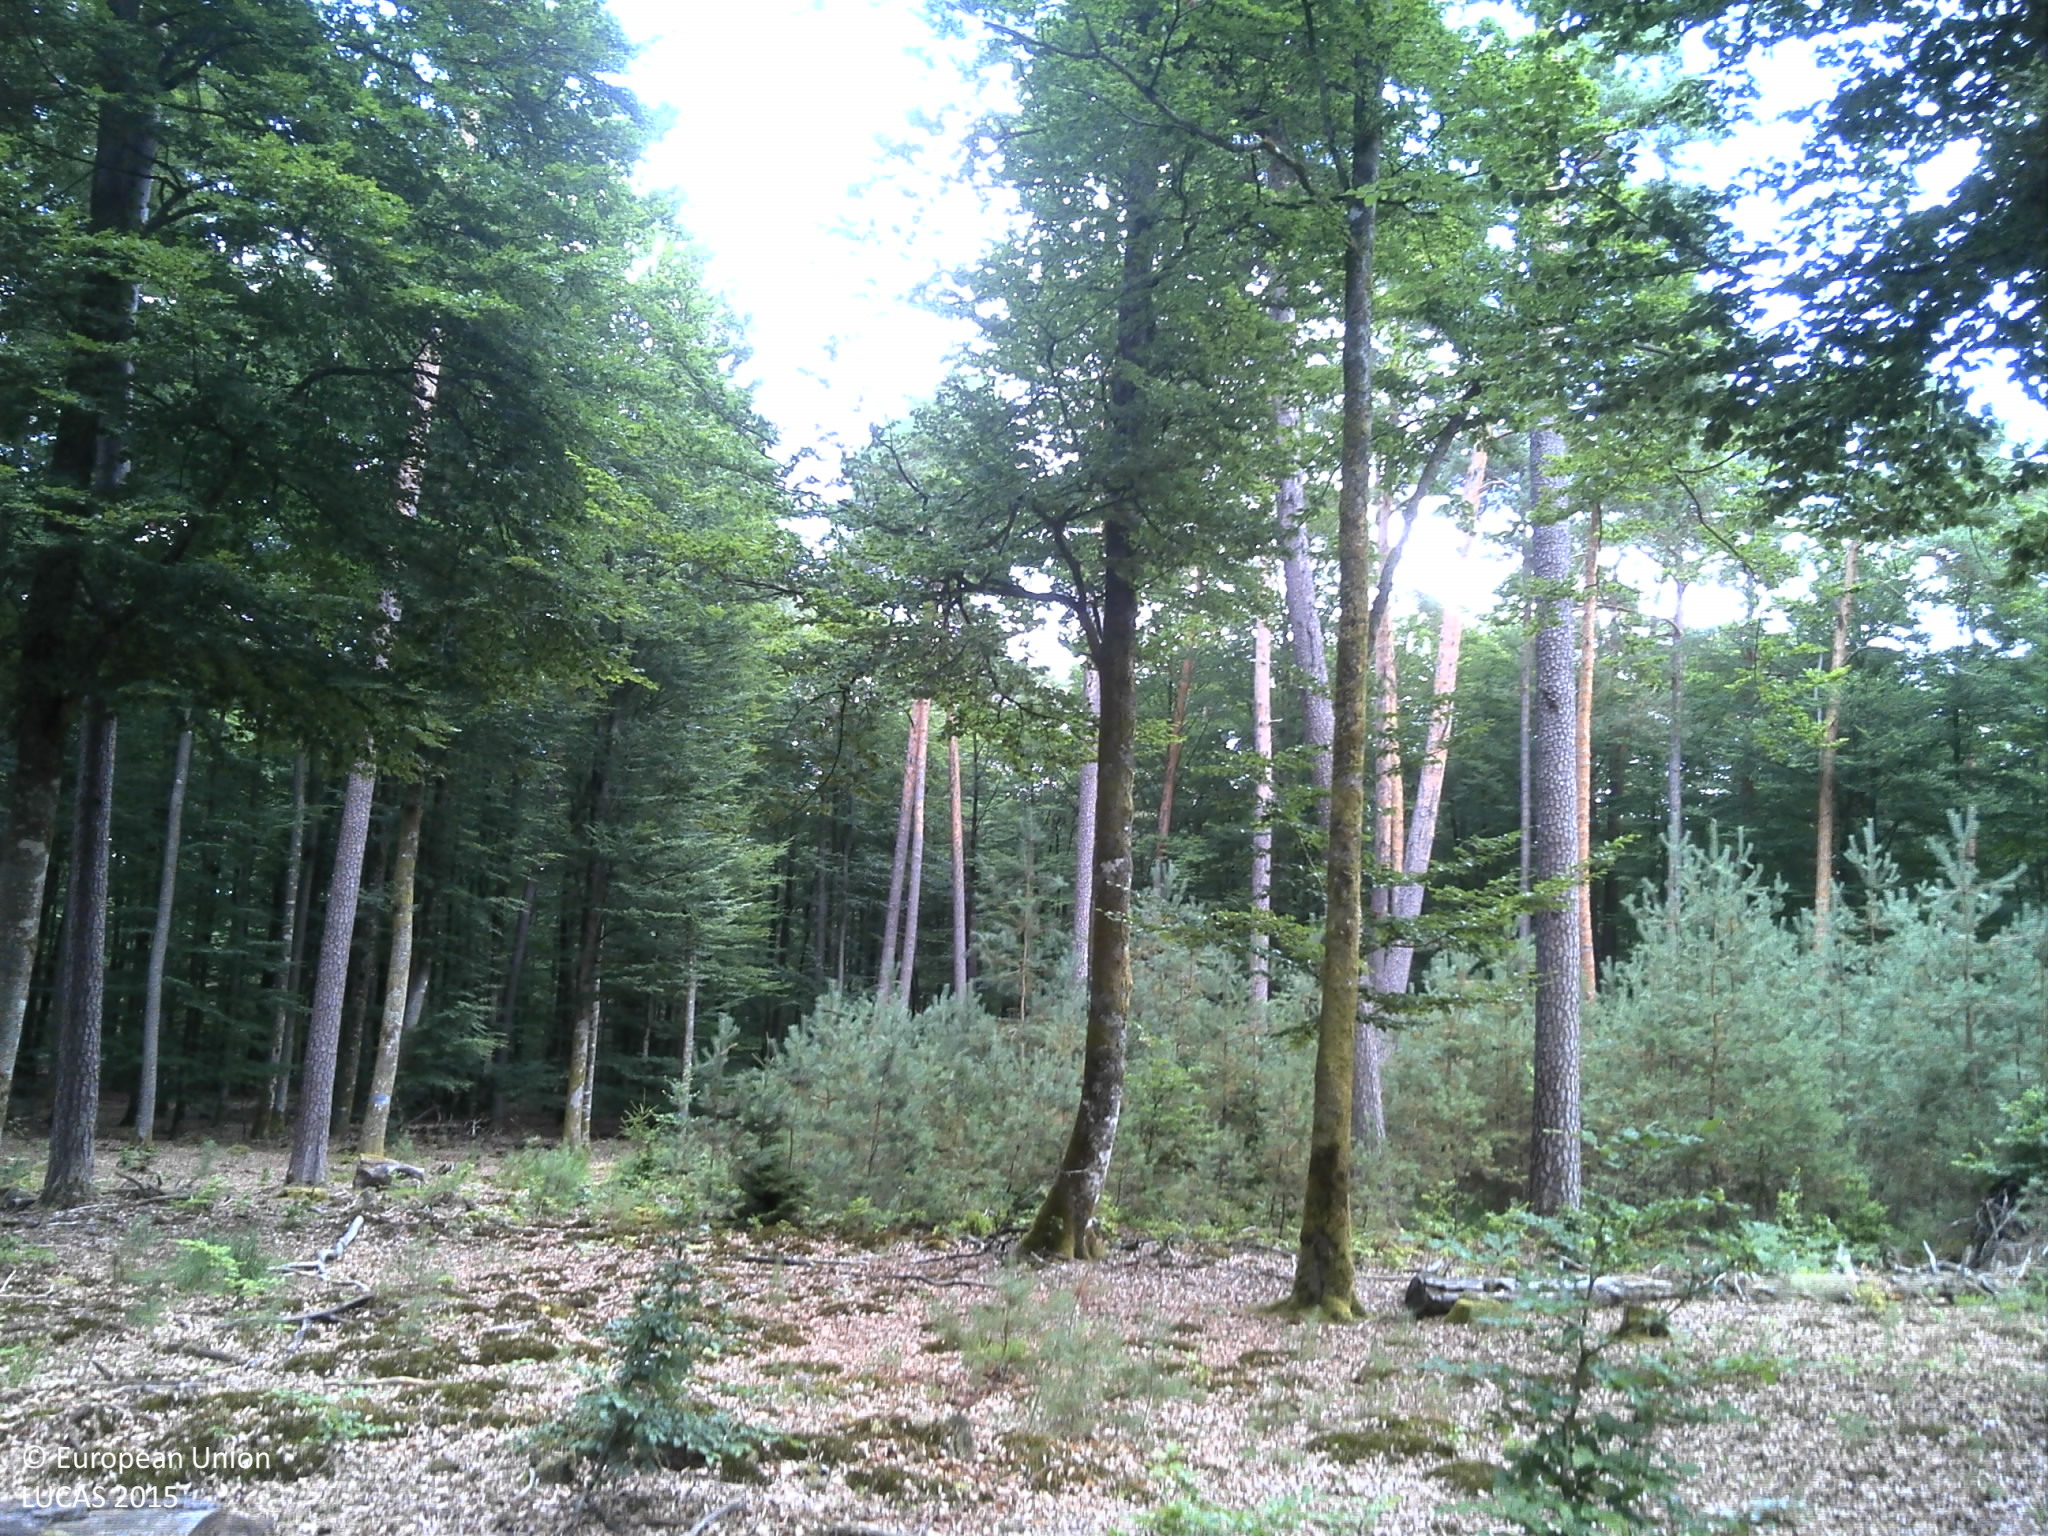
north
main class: Woodland
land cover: Pine dominated mixed woodland
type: hemiboreal forest and nemoral coniferous forest and mixed broadleaved-coniferous forest
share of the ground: > 75 %
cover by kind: coniferous forest trees 40 %, broadleaved forest trees 40 %, unconsolidated bare surface 10 %, herbaceous plants 5 %, lichens and mosses 5 %
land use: Forestry
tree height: > 5 m
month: July
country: FR
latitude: 49.0441
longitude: 7.6338
